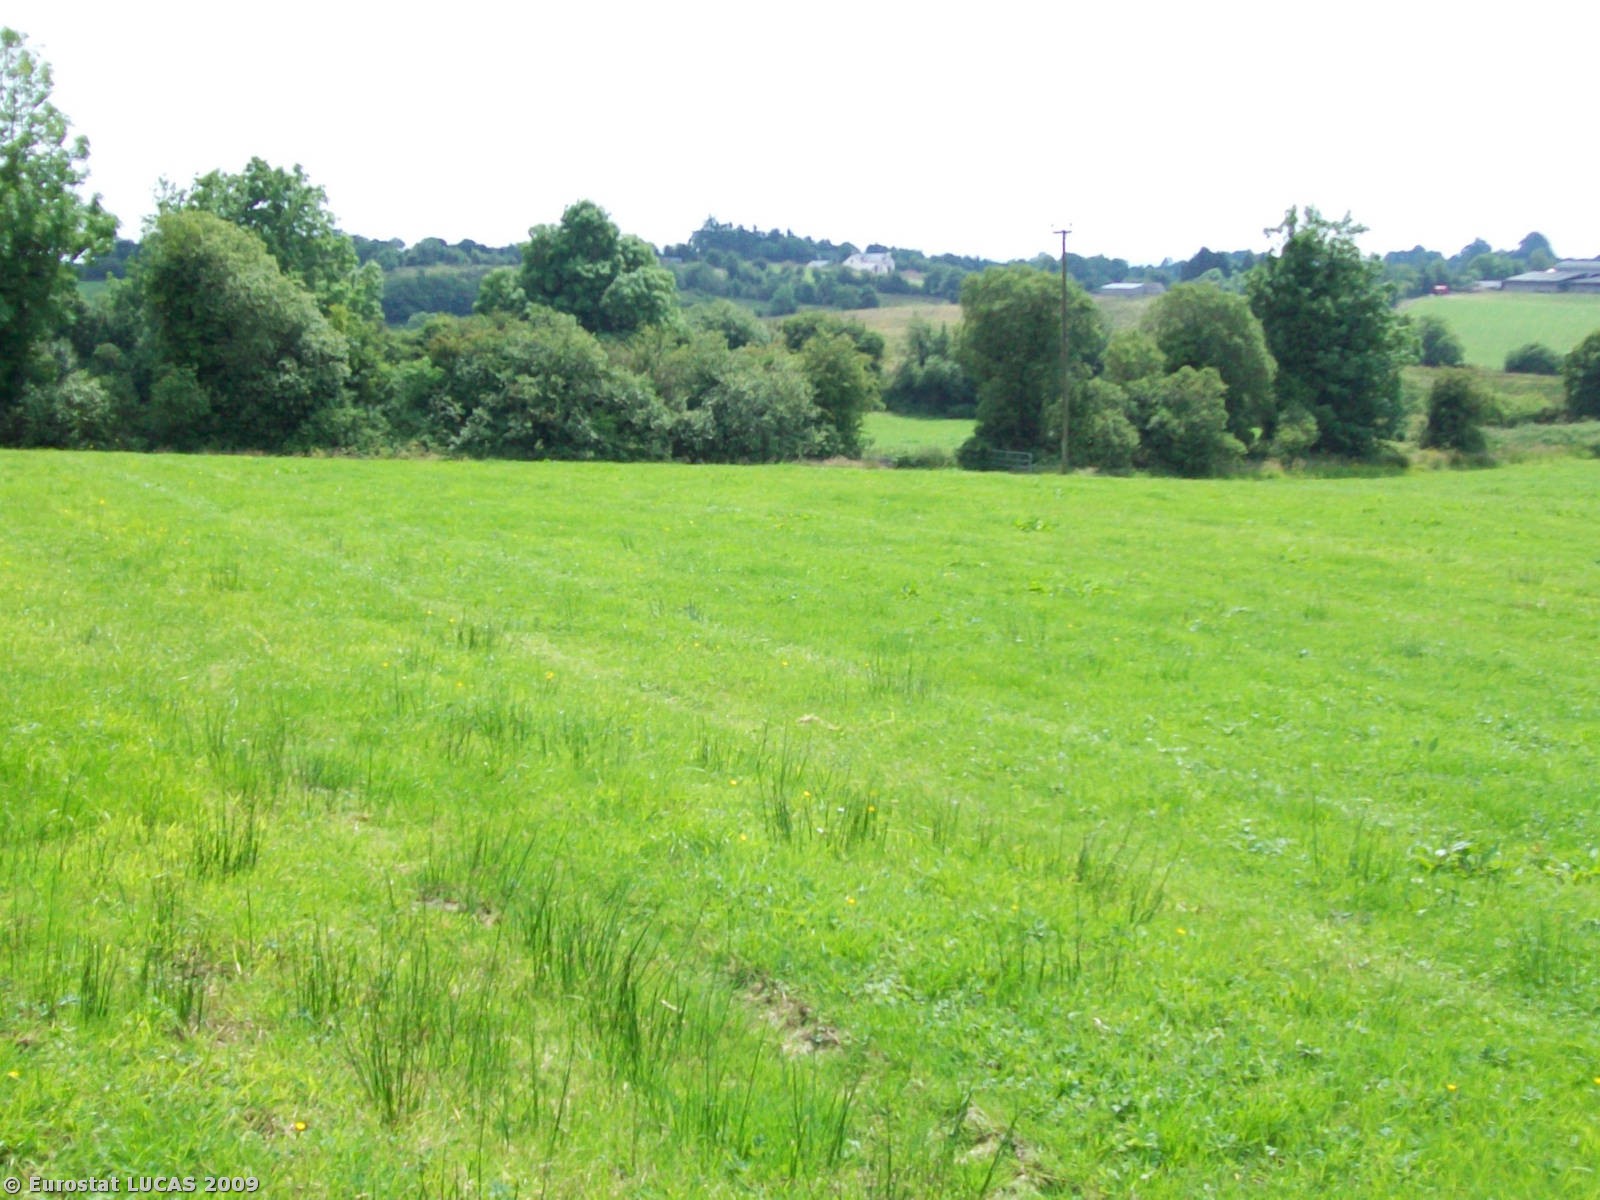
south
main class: Grassland
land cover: Grassland without tree/shrub cover
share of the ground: > 75 %
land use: Agriculture (excluding fallow land and kitchen gardens)
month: June
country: GB
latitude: 54.2526
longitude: -7.2308
